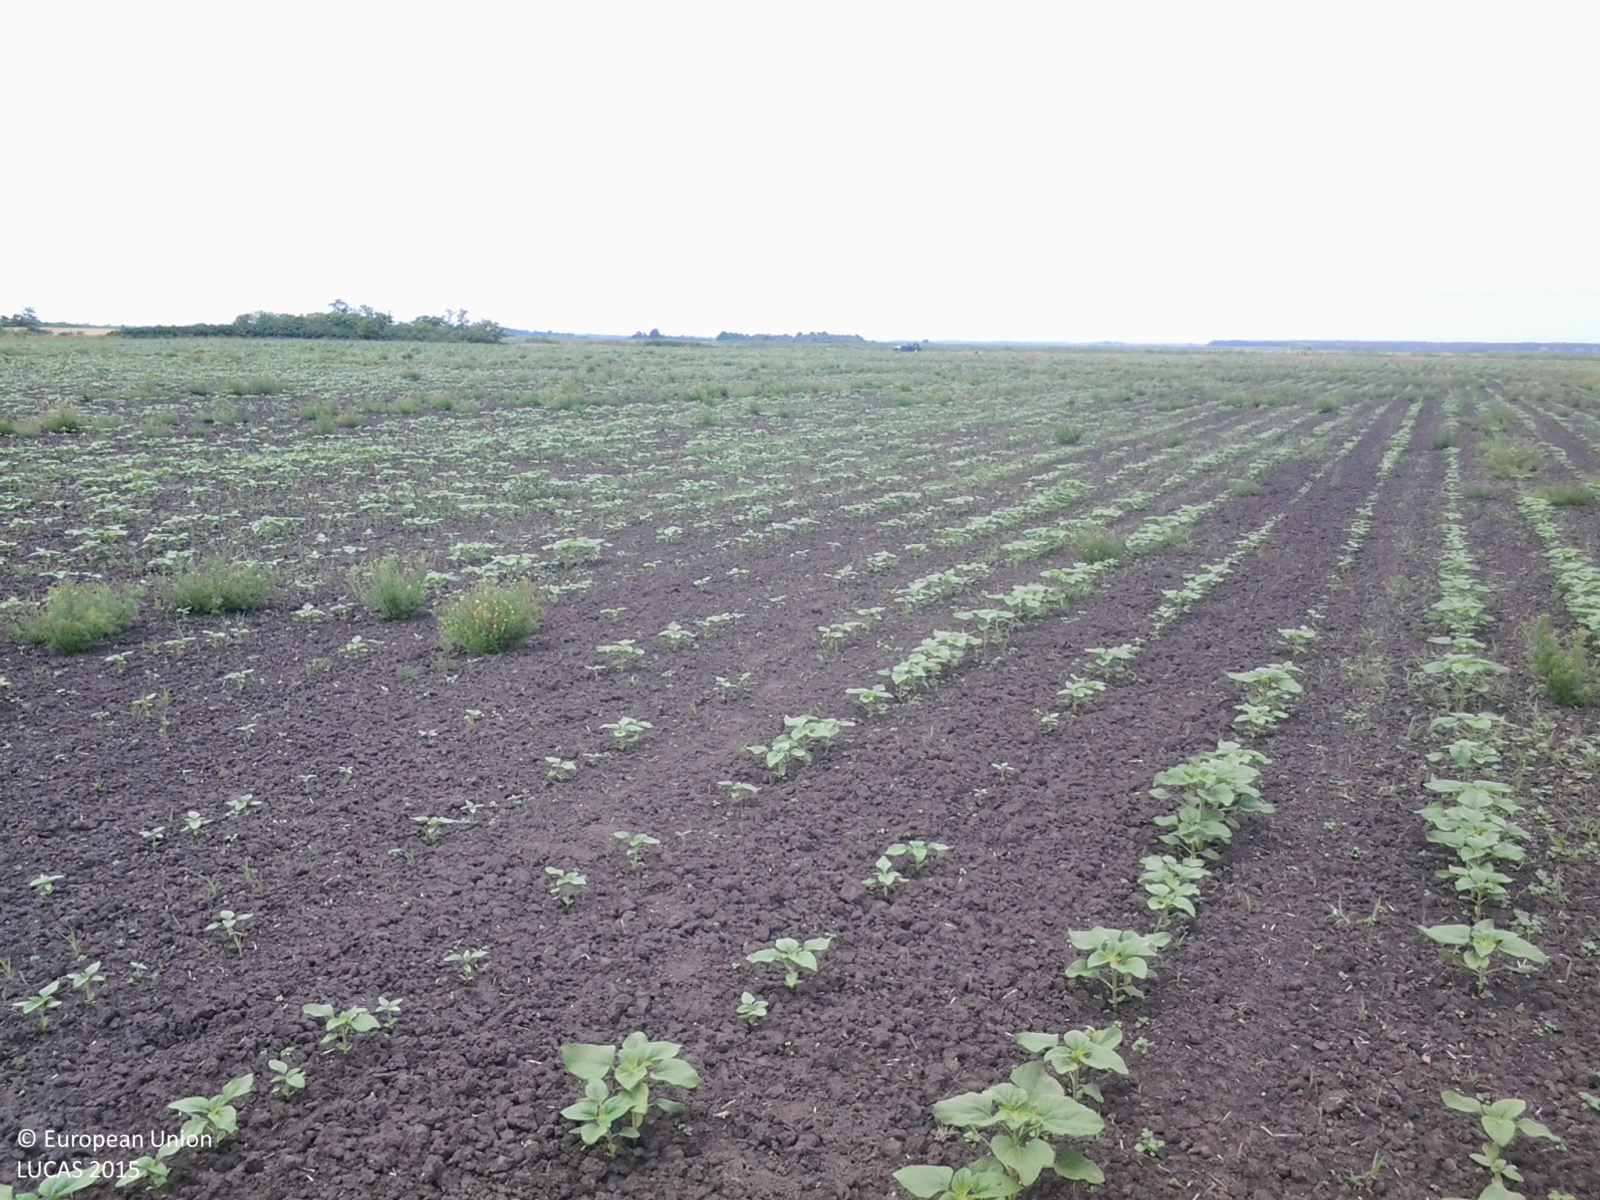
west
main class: Cropland
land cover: Sunflower
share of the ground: < 10 %
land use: Agriculture (excluding fallow land and kitchen gardens)
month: June
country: HU
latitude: 46.8210
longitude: 20.4215
